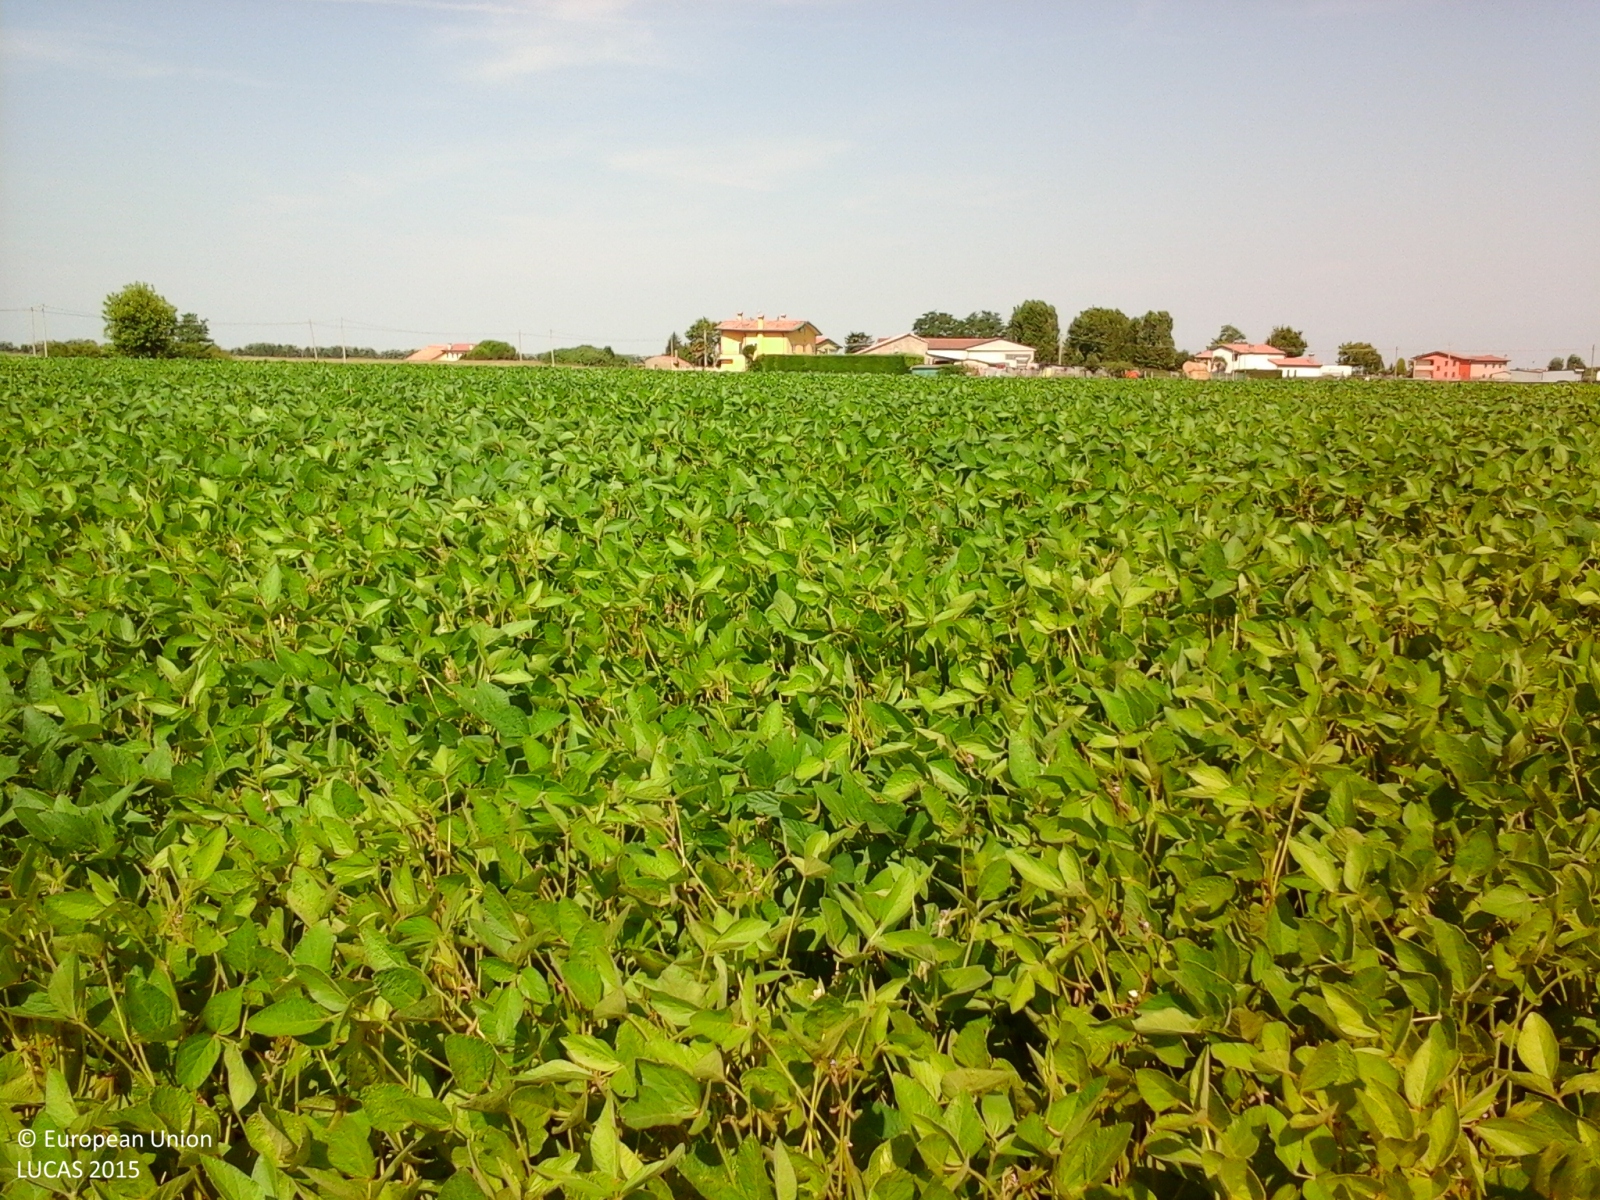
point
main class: Cropland
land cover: Soya
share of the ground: > 75 %
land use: Agriculture (excluding fallow land and kitchen gardens)
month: July
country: IT
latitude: 45.2111
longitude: 12.1990
